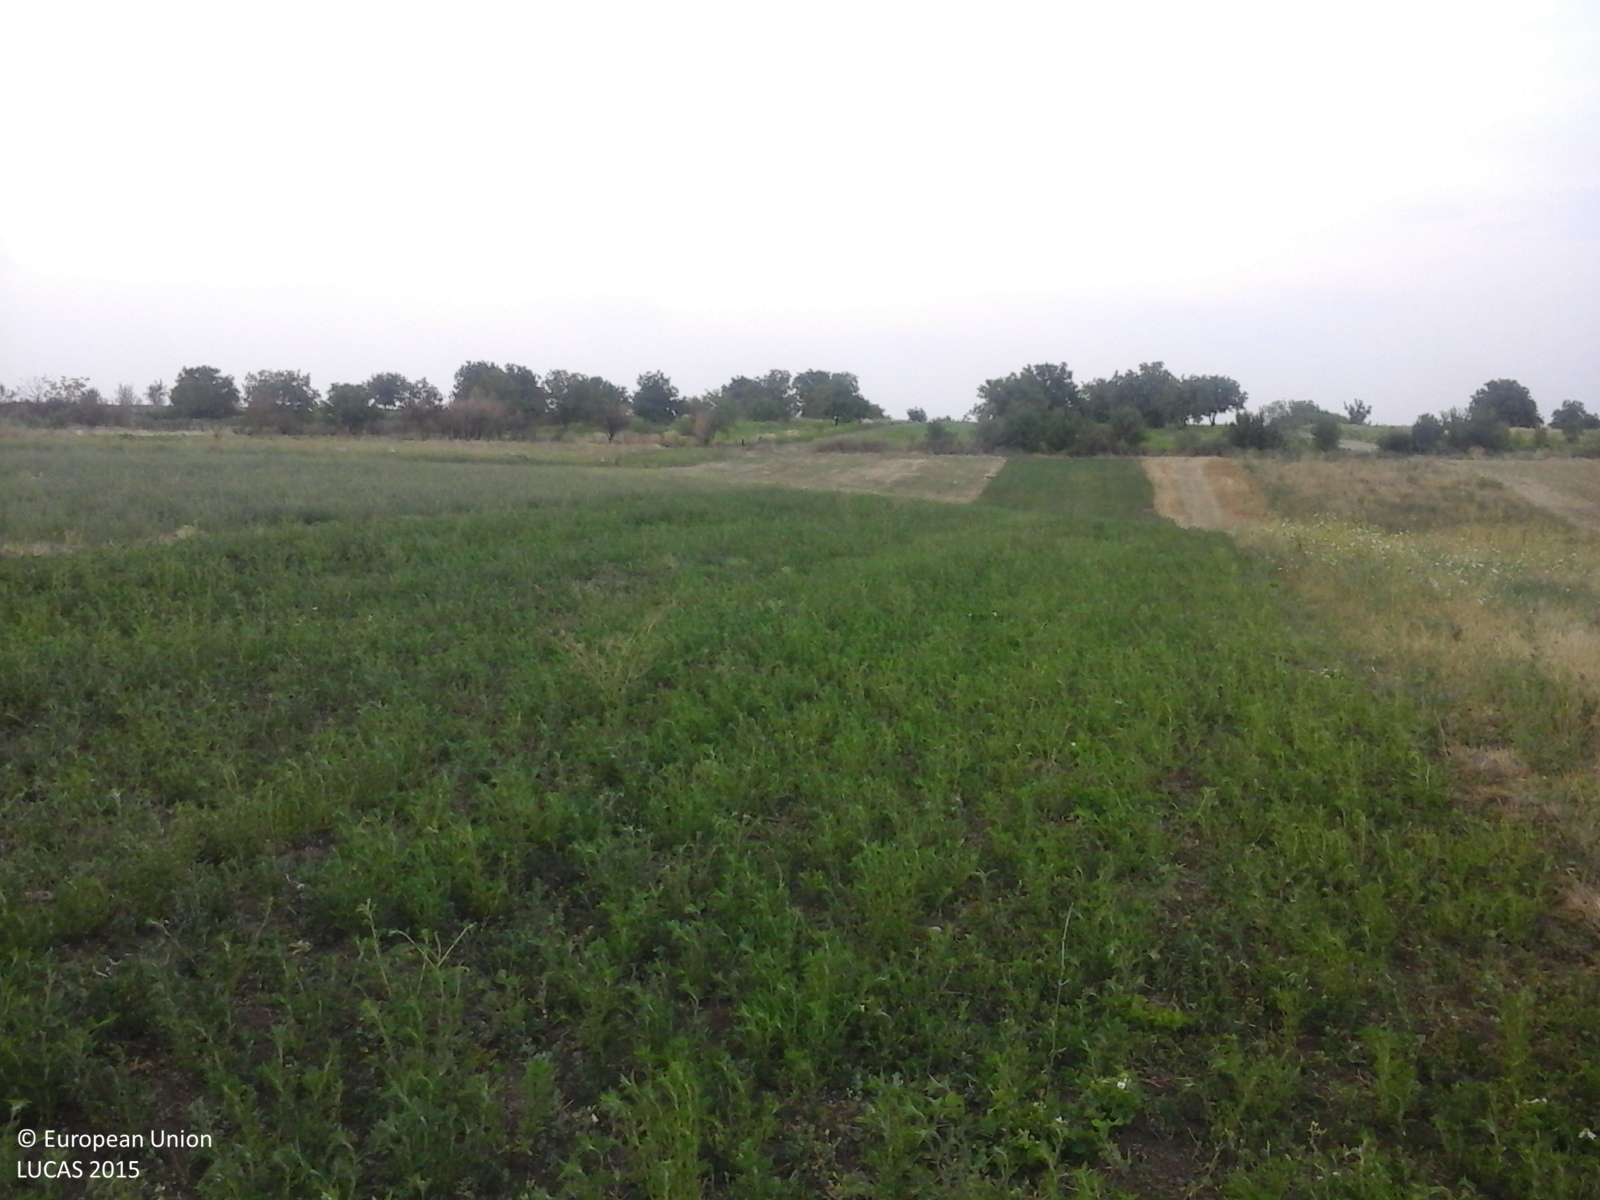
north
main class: Cropland
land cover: Lucerne
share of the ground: > 75 %
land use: Agriculture (excluding fallow land and kitchen gardens)
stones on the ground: < 10 %
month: August
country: RO
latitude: 44.3194
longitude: 23.0979
